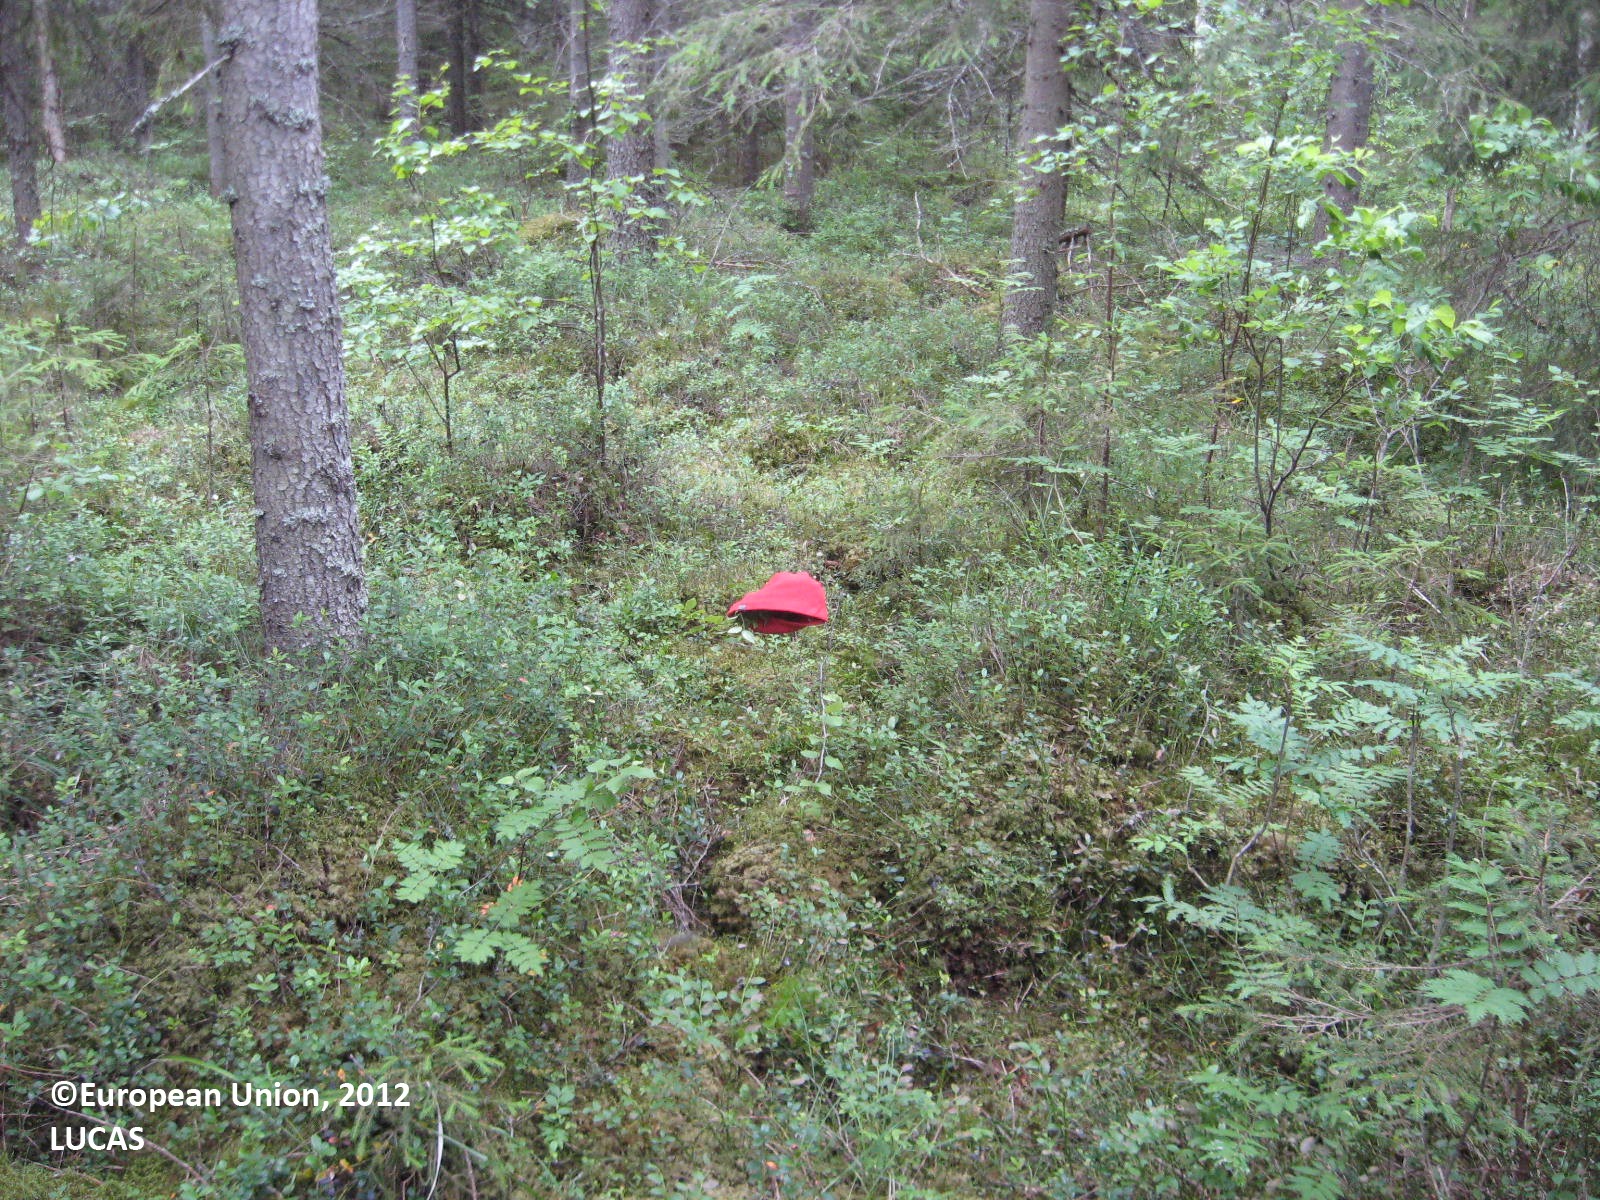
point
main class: Woodland
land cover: Spruce dominated coniferous woodland
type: boreal forest
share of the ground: > 75 %
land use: Forestry
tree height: > 5 m
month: July
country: FI
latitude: 62.5125
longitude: 21.5604
